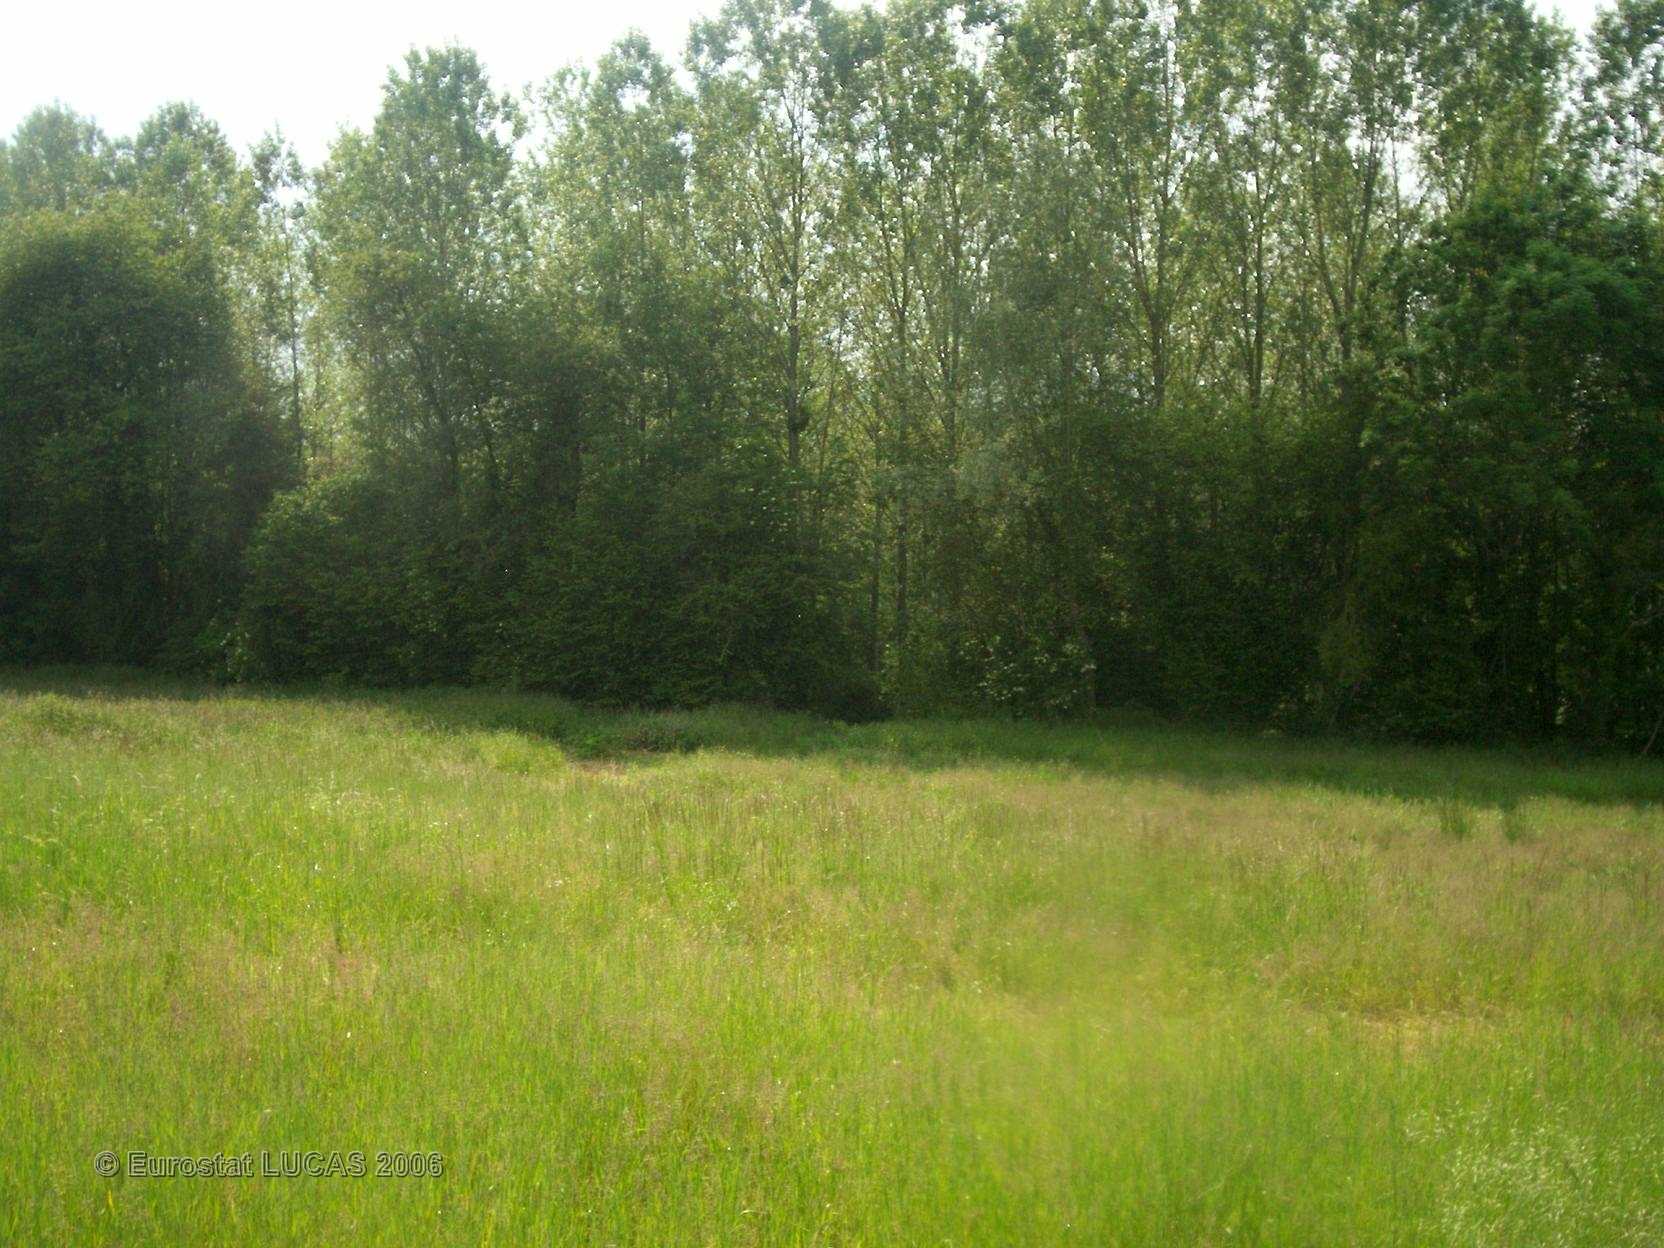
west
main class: Grassland
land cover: Grassland without tree/shrub cover
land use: Agriculture (excluding fallow land and kitchen gardens)
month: June
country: FR
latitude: 49.6962
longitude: 2.6827
